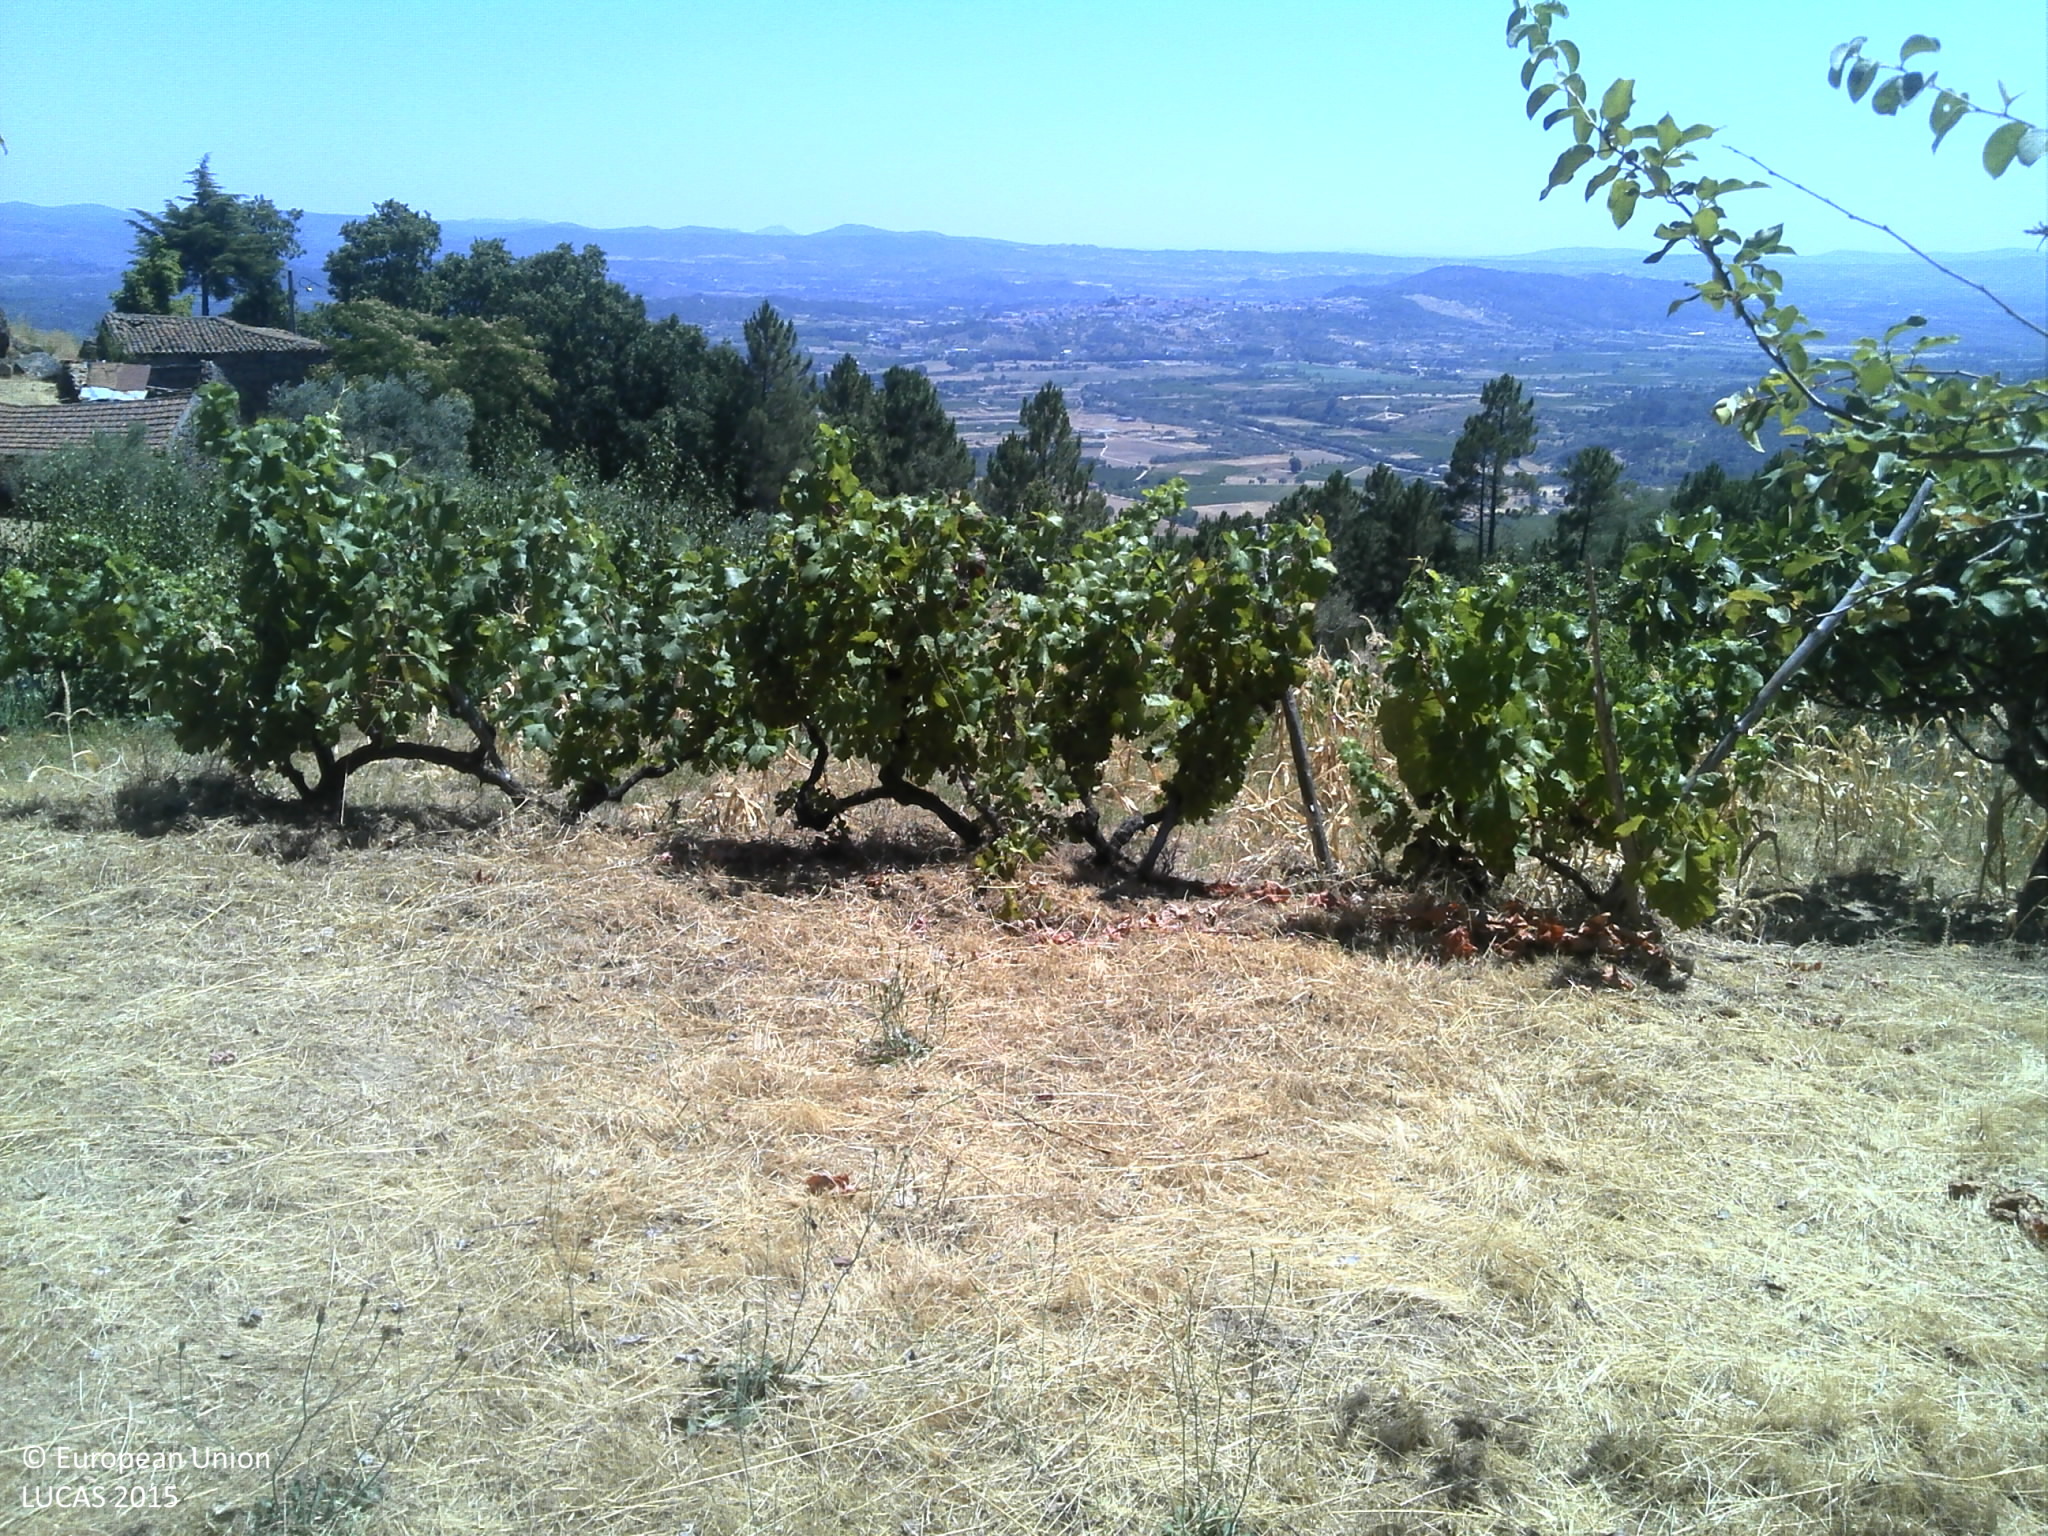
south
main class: Cropland
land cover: Pear fruit
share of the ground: 10 - 25 %
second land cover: Maize
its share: < 10 %
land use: Agriculture (excluding fallow land and kitchen gardens)
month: July
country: PT
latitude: 40.4200
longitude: -7.3726
